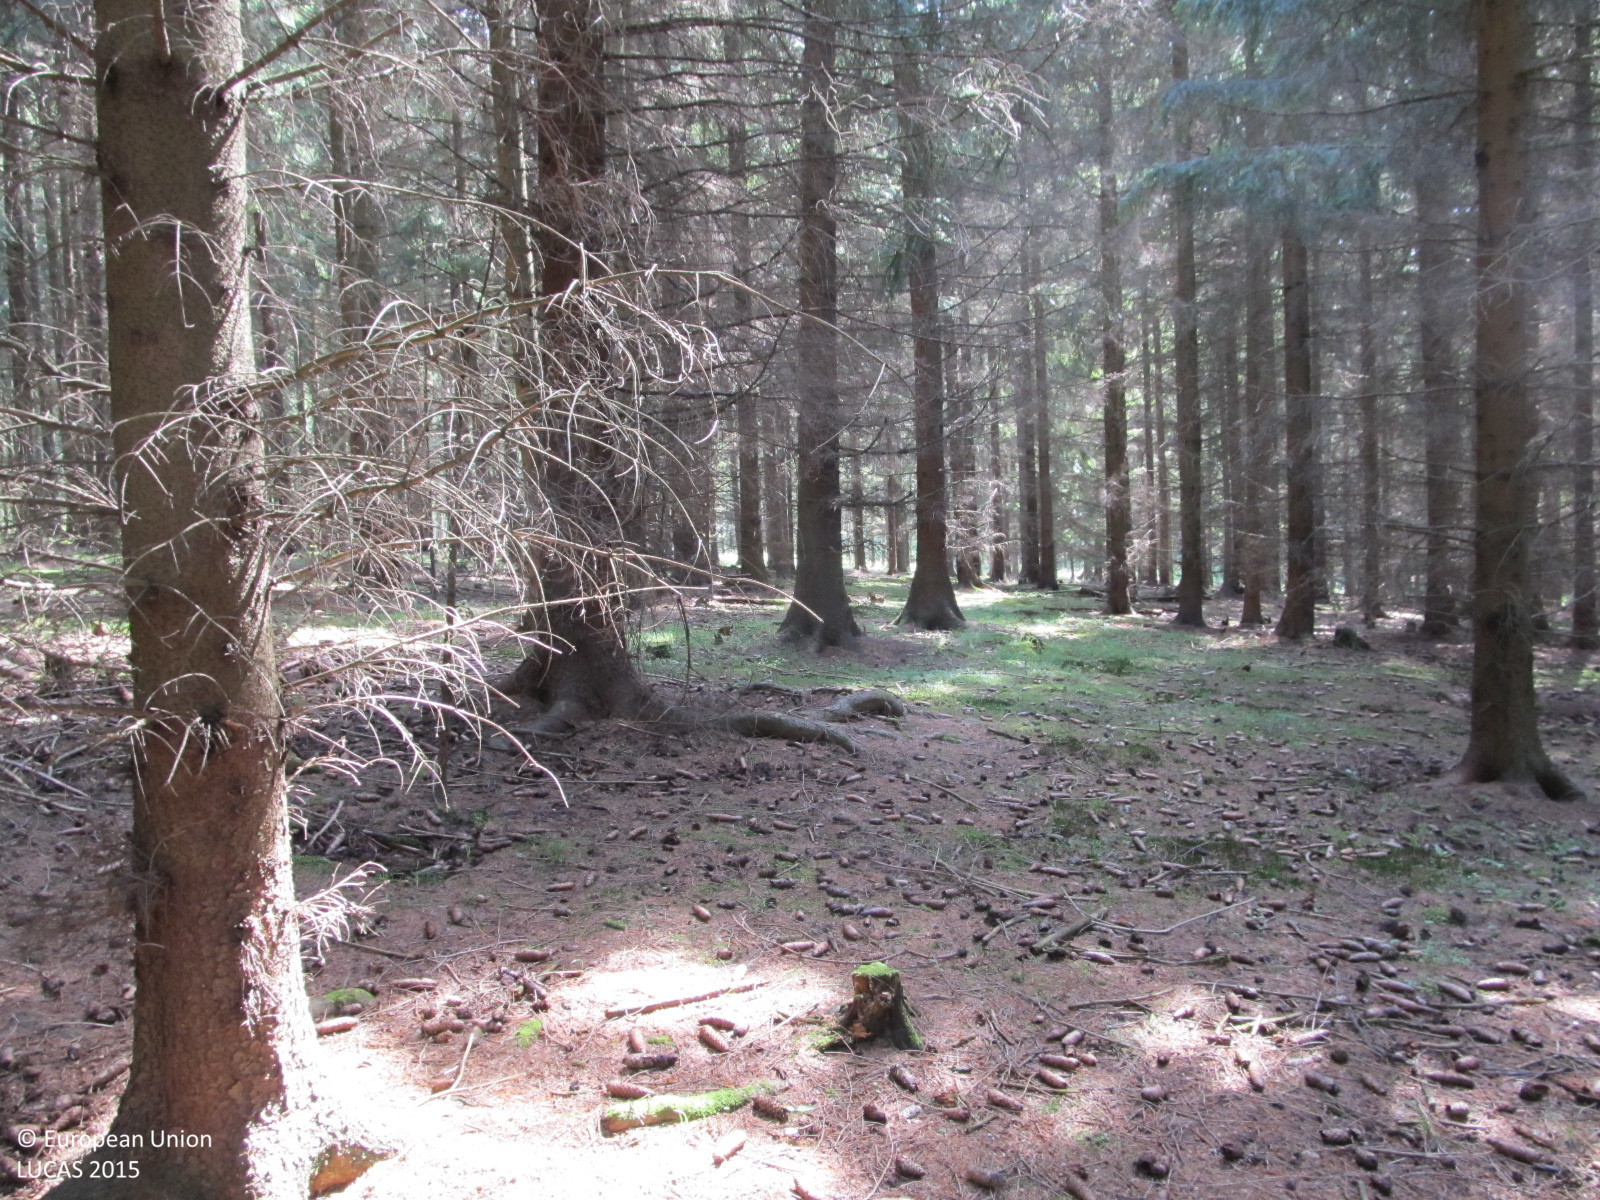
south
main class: Woodland
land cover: Spruce dominated coniferous woodland
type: hemiboreal forest and nemoral coniferous forest and mixed broadleaved-coniferous forest
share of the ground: > 75 %
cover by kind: coniferous forest trees 80 %, unconsolidated bare surface 20 %
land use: Forestry
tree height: > 5 m
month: August
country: AT
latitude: 48.7337
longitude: 15.5369
